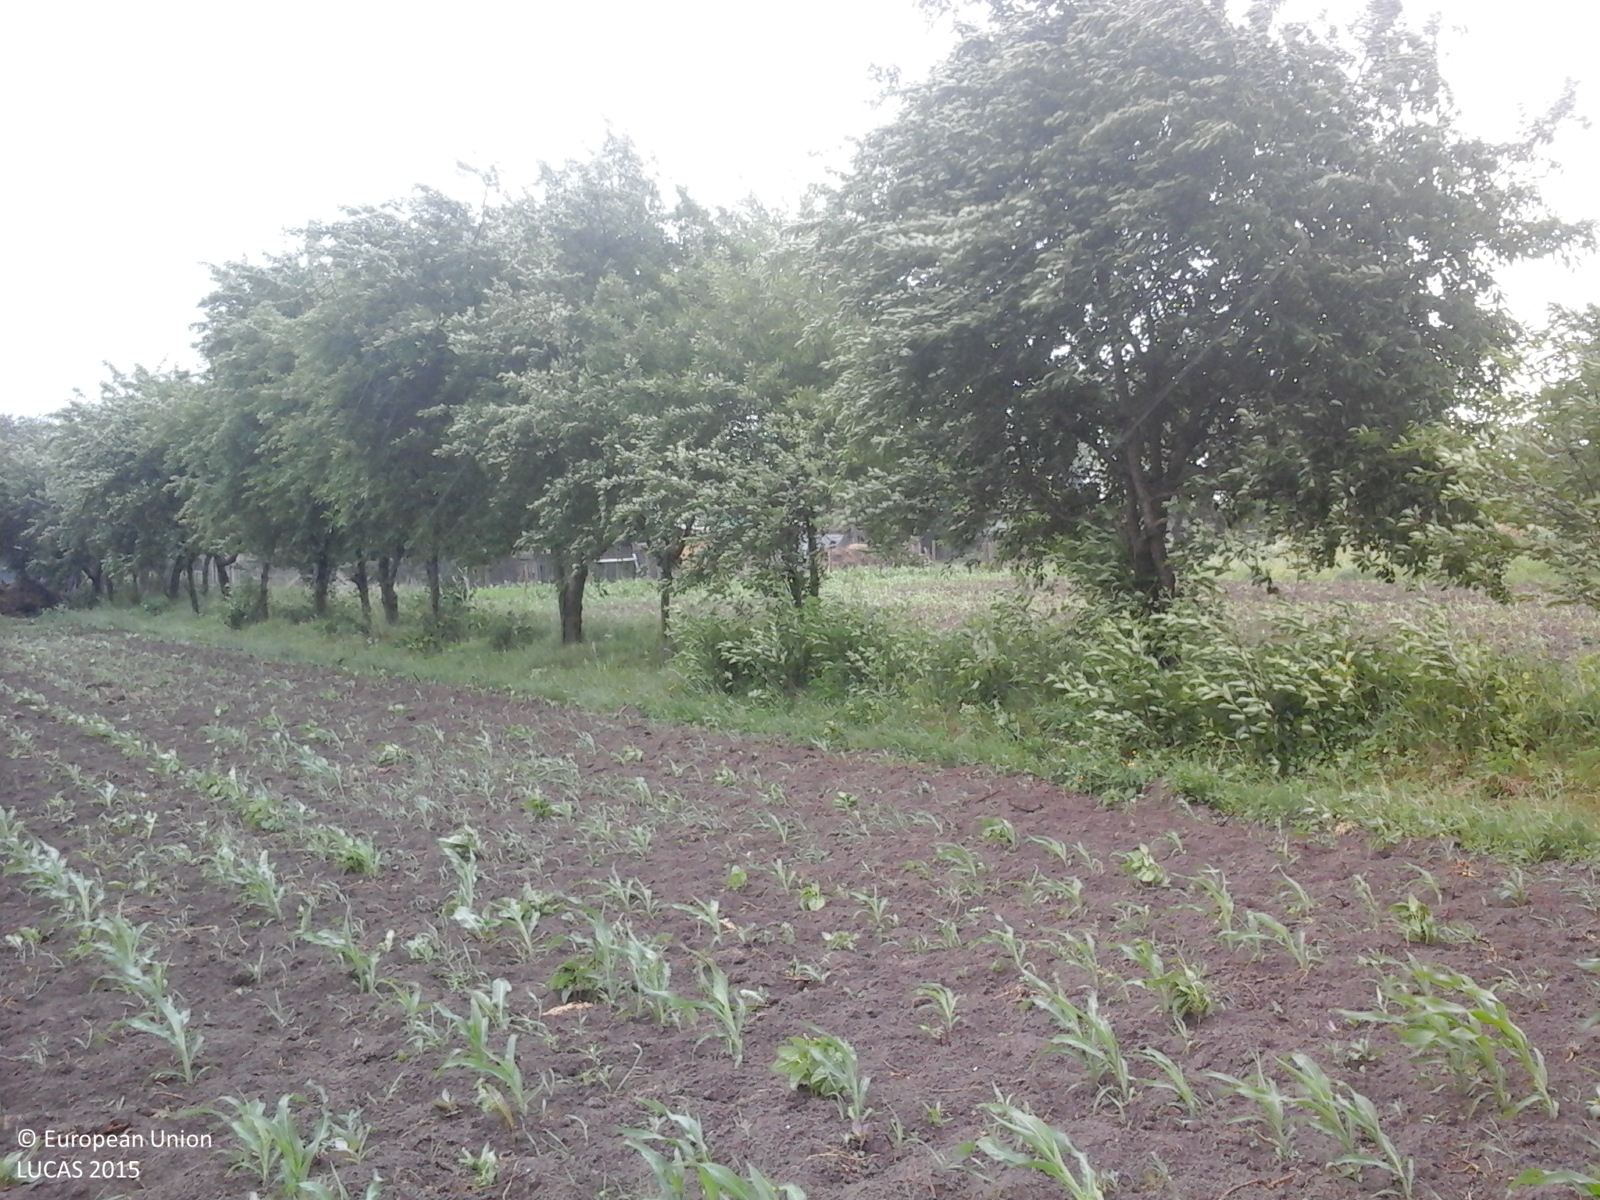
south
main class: Cropland
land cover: Maize
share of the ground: 10 - 25 %
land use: Agriculture (excluding fallow land and kitchen gardens)
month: June
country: RO
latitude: 47.1967
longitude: 26.3310
